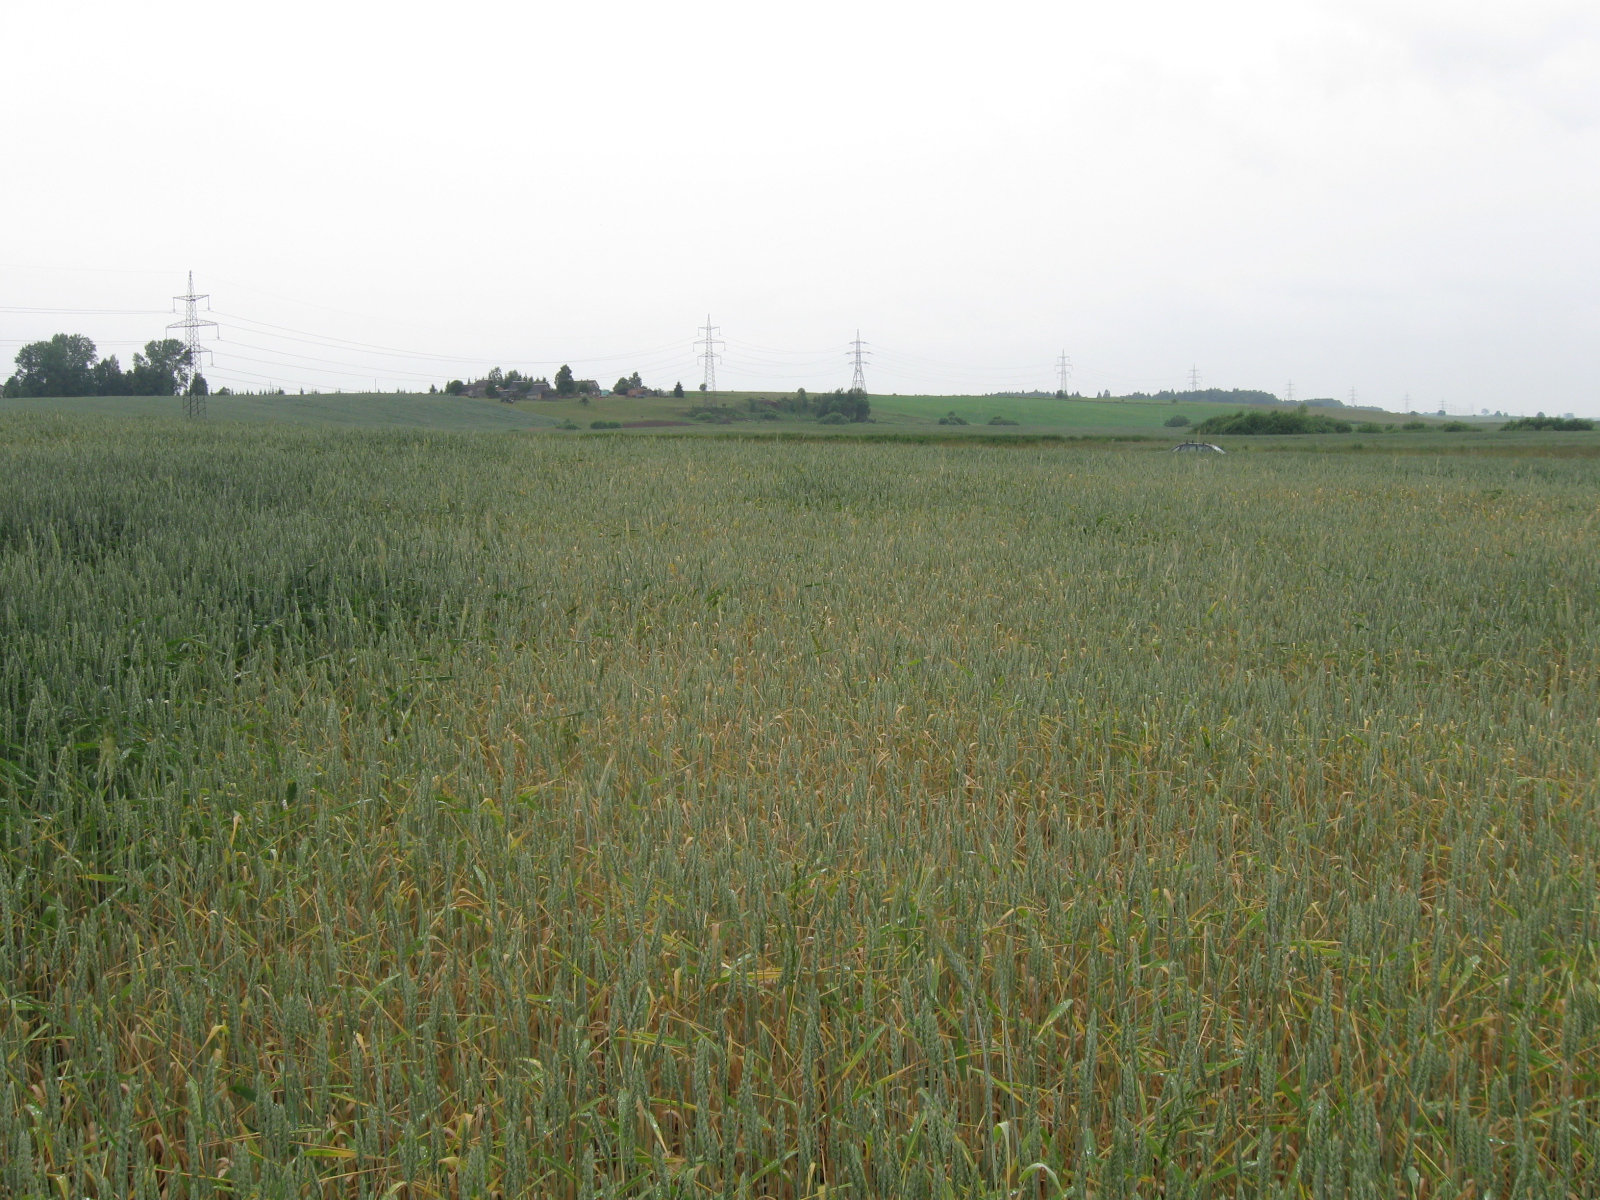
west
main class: Cropland
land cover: Common wheat
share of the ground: > 75 %
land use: Agriculture (excluding fallow land and kitchen gardens)
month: June
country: LT
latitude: 54.8028
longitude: 24.3966
